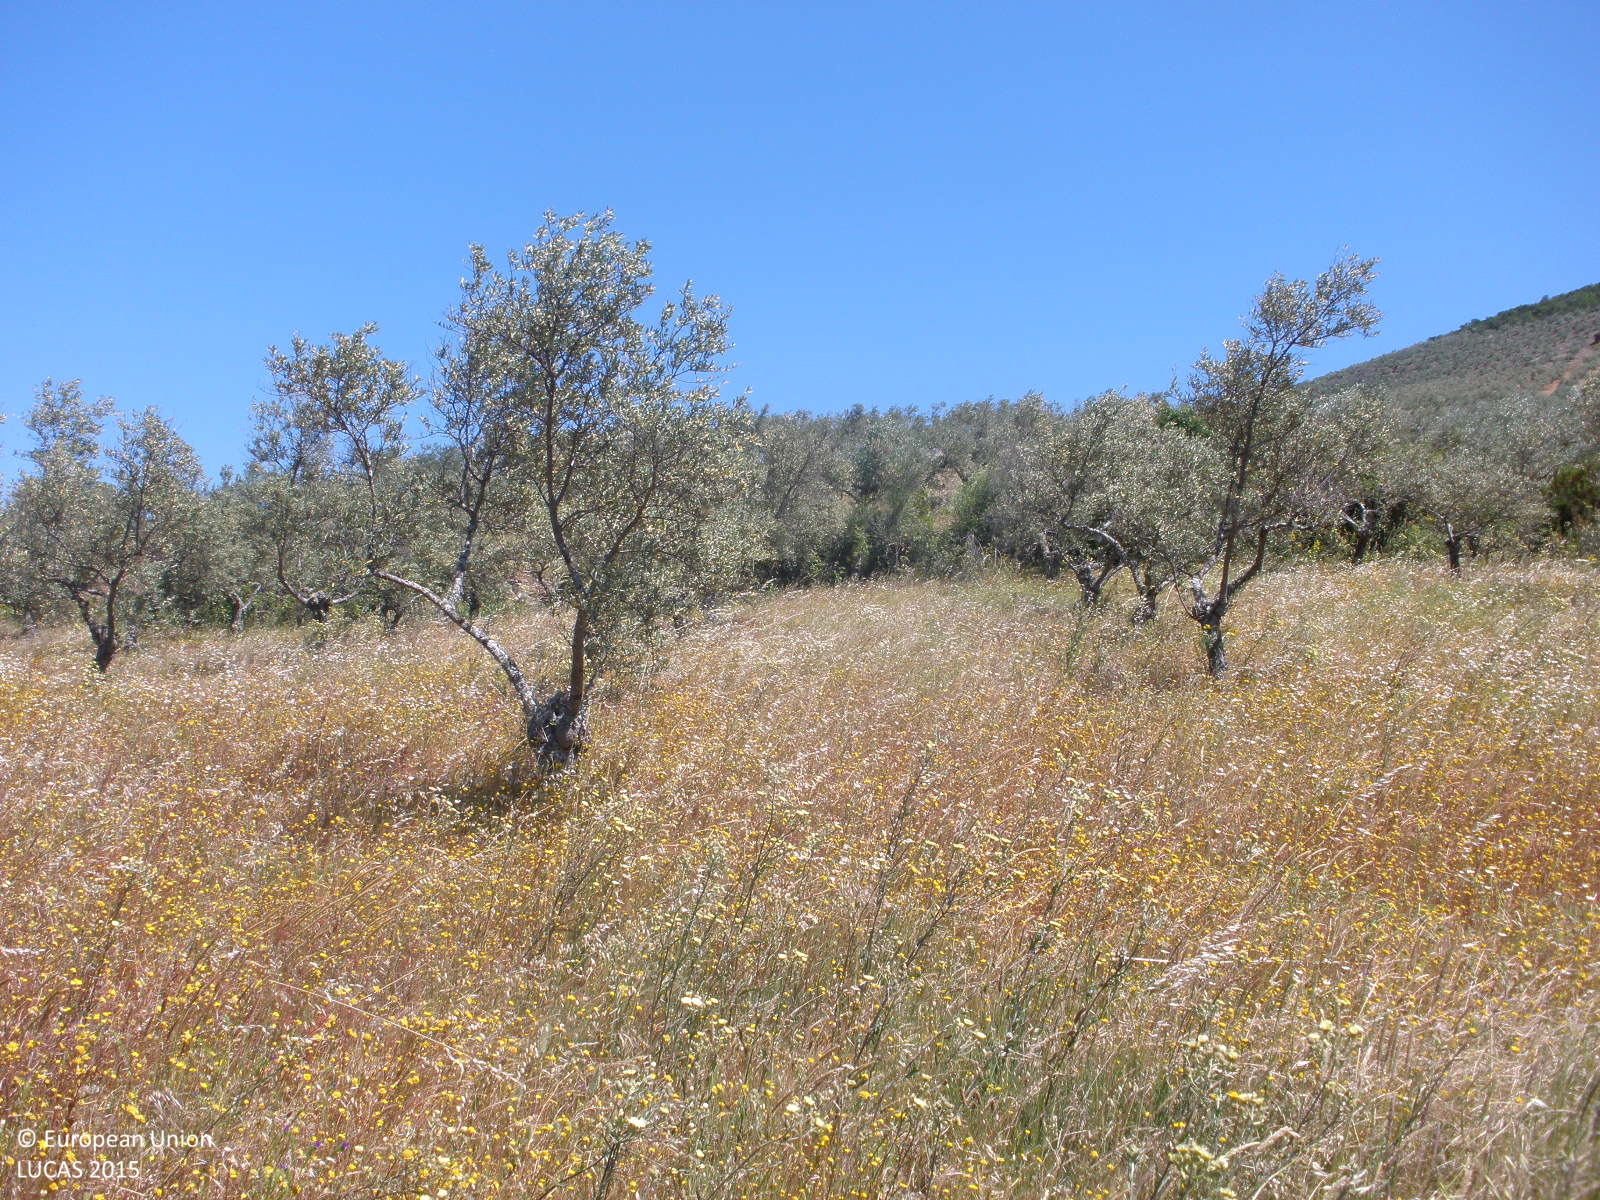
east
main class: Shrubland
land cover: Shrubland without tree cover
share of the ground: > 75 %
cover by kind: shrubs 90 %, herbaceous plants 10 %
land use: Semi-natural and natural areas not in use
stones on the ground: > 50 %
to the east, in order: Shrubland without tree cover; Spontaneously vegetated surfaces; Olive groves; Dry stone walls; Shruby margins; Olive groves; Tracks; Olive groves
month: May
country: ES
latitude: 40.3196
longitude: -6.1408
